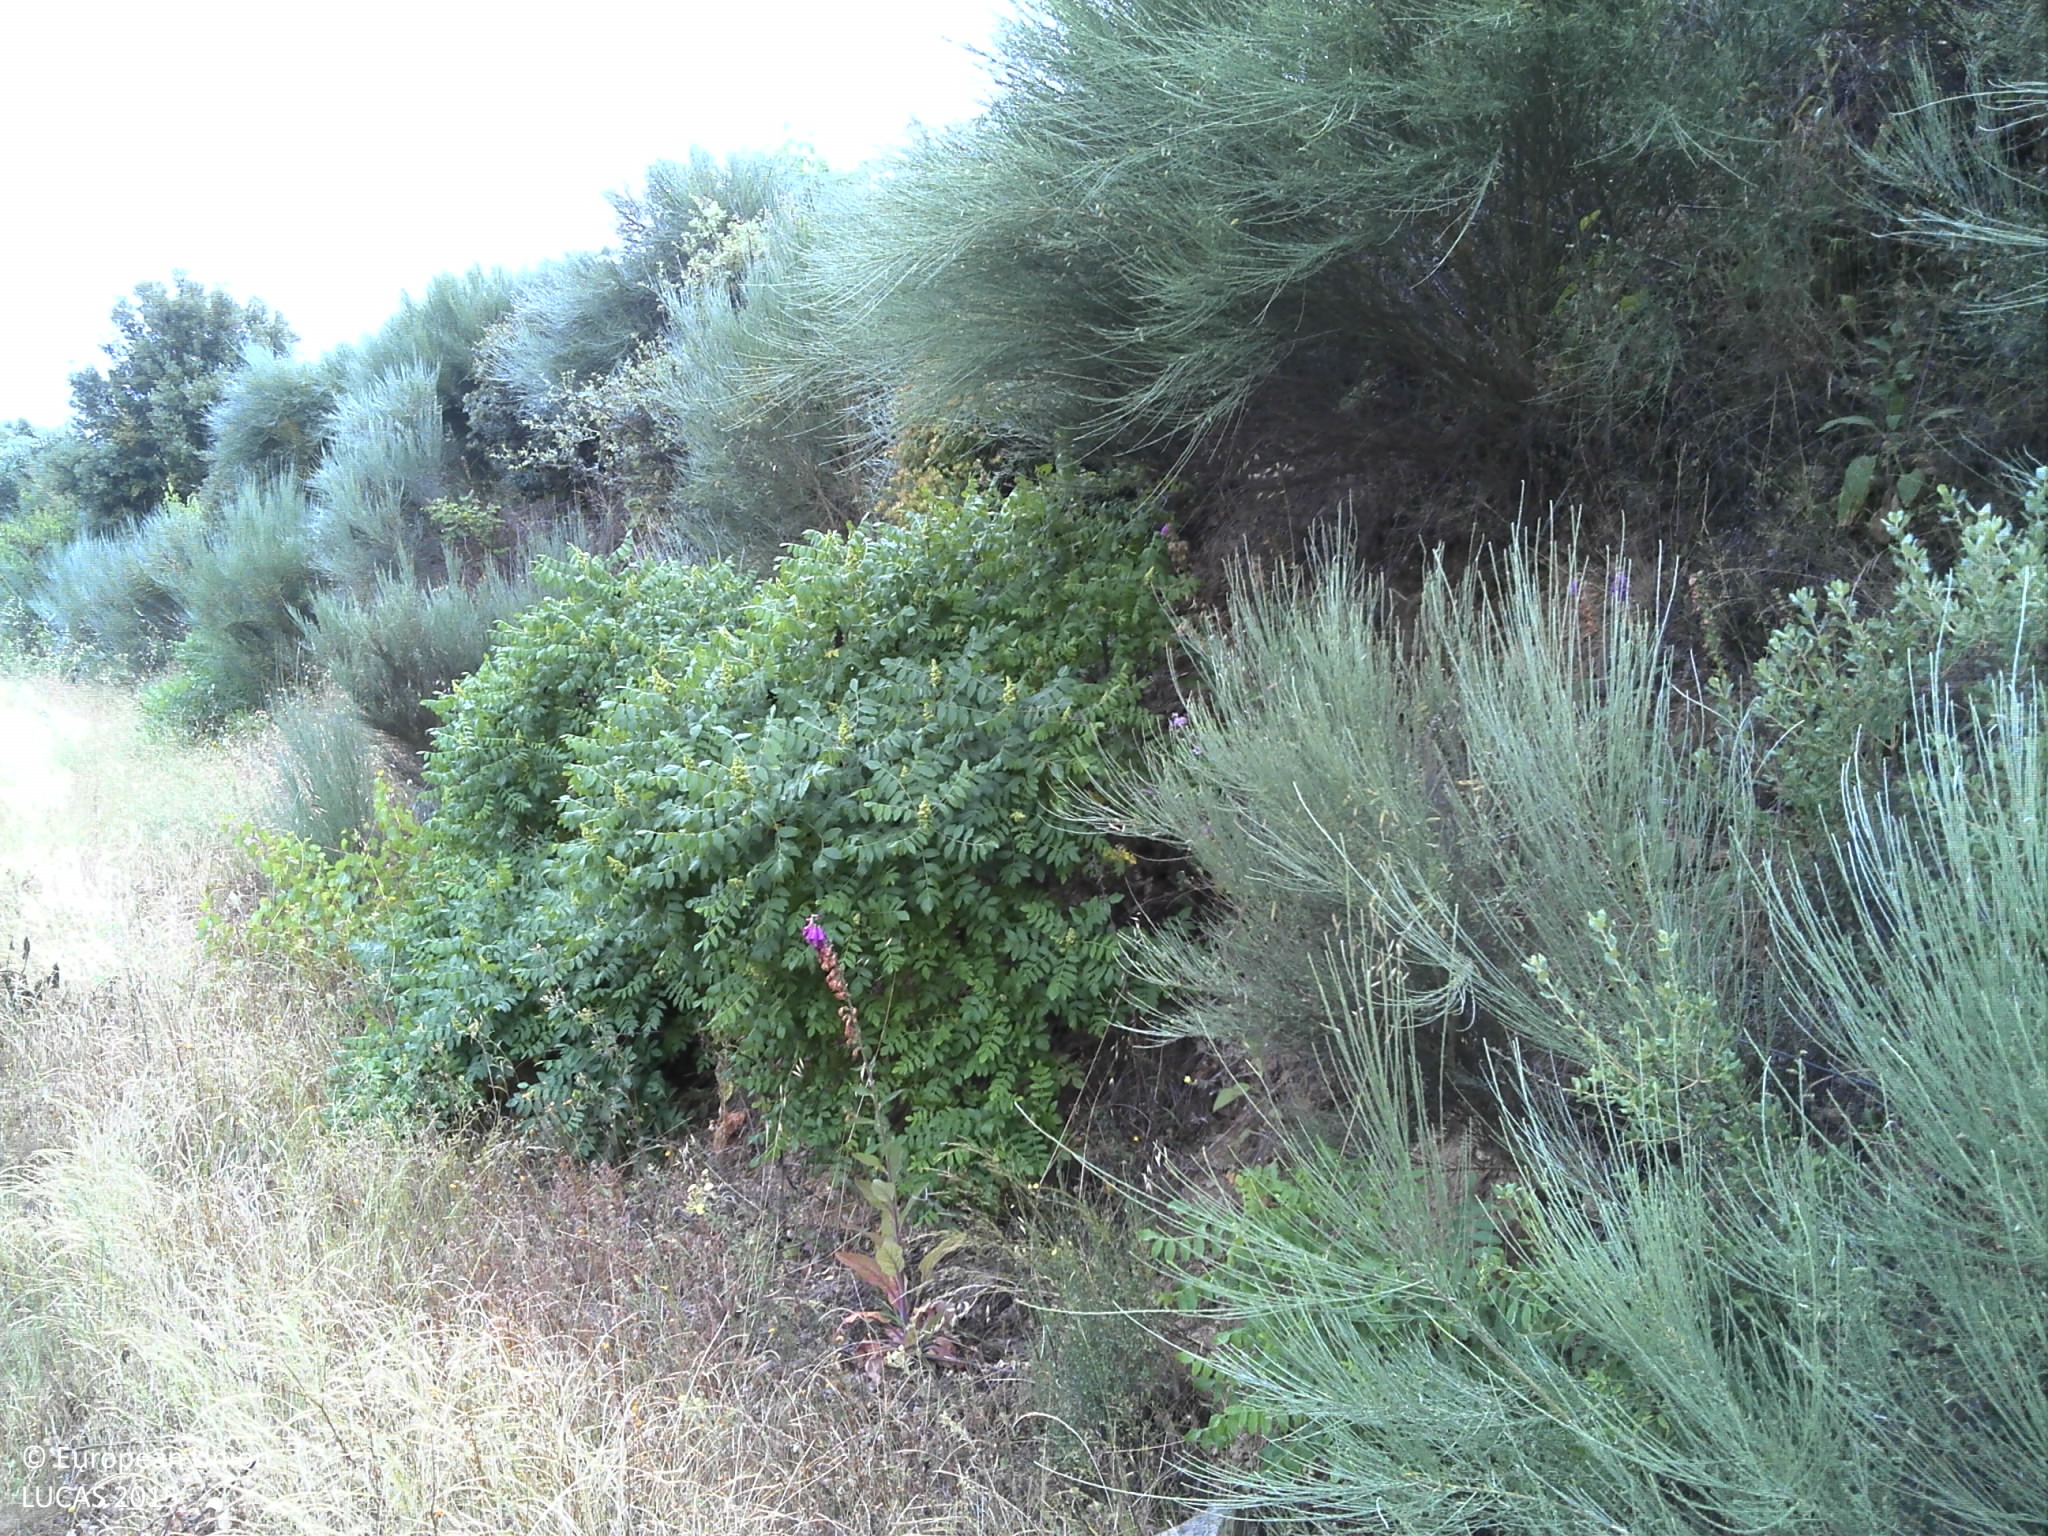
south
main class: Cropland
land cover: Vineyards
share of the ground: < 10 %
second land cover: Spontaneously vegetated surfaces
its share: 10 - 25 %
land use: Agriculture (excluding fallow land and kitchen gardens)
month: June
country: PT
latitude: 41.1469
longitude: -7.4324
